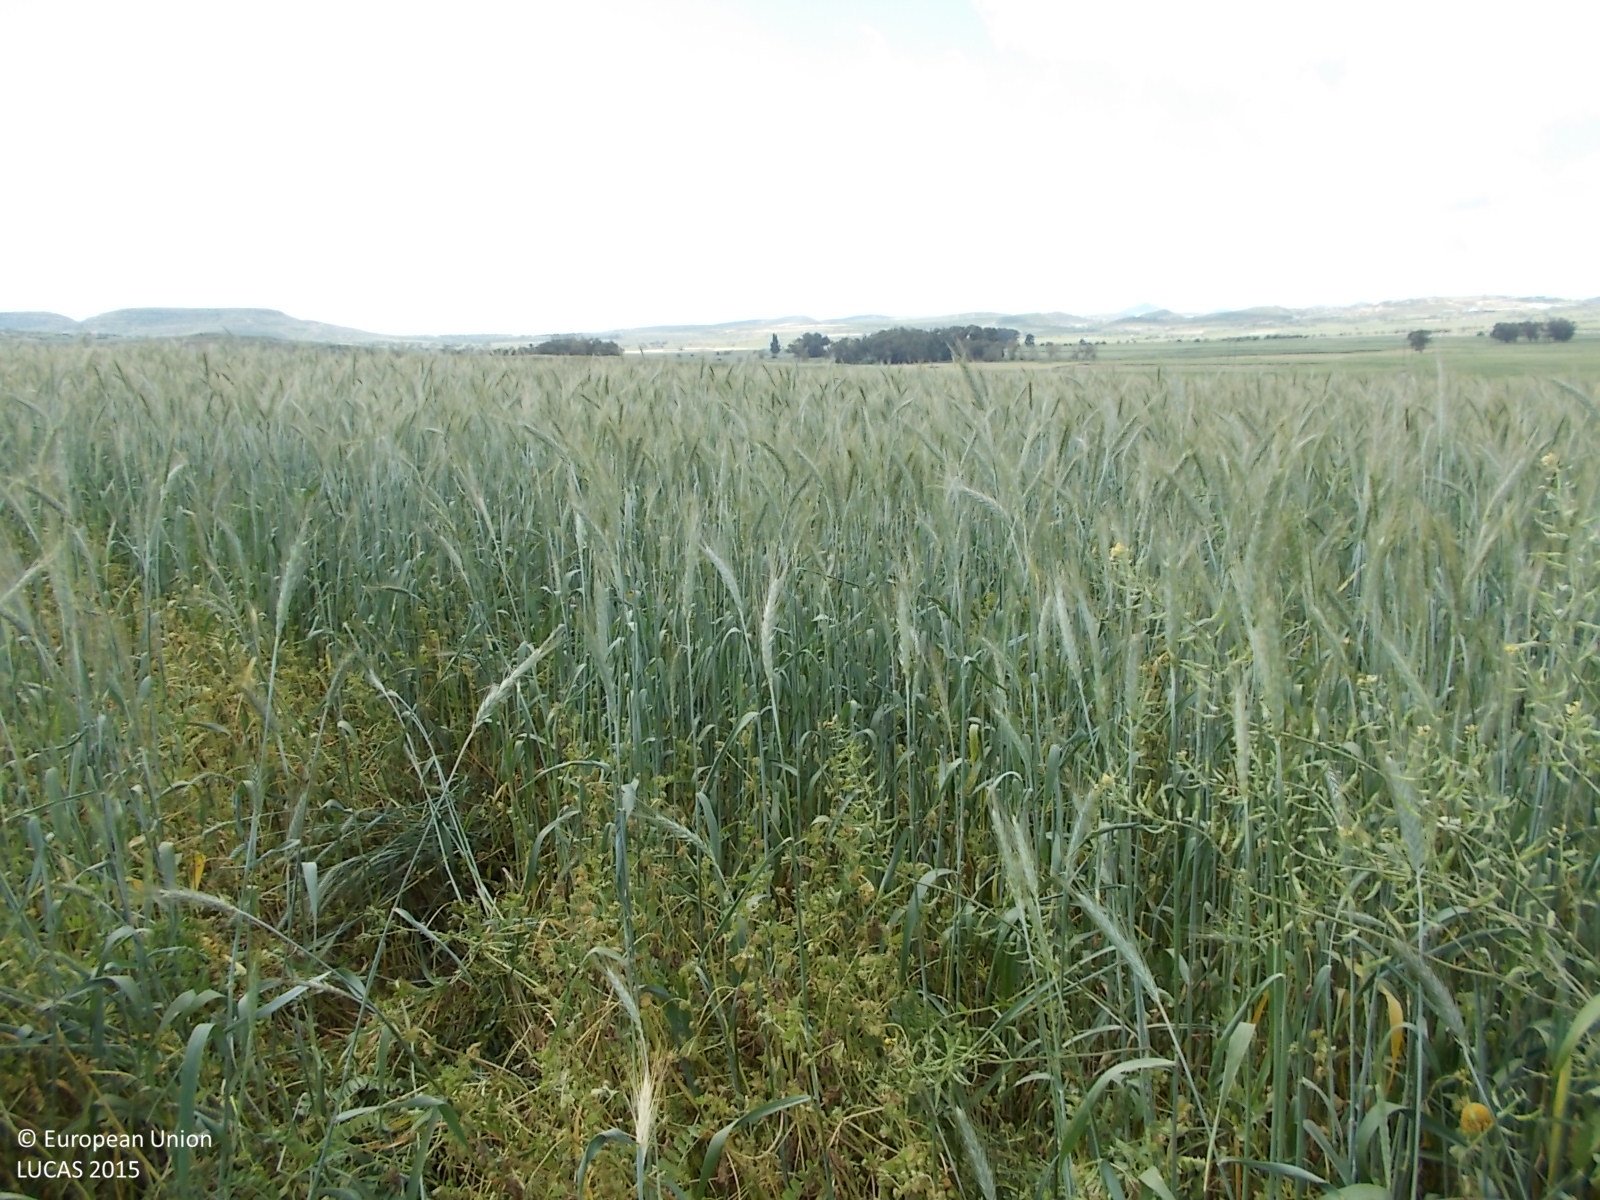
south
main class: Cropland
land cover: Mixed cereals for fodder
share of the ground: > 75 %
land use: Agriculture (excluding fallow land and kitchen gardens)
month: April
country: CY
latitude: 35.0427
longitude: 33.4902
